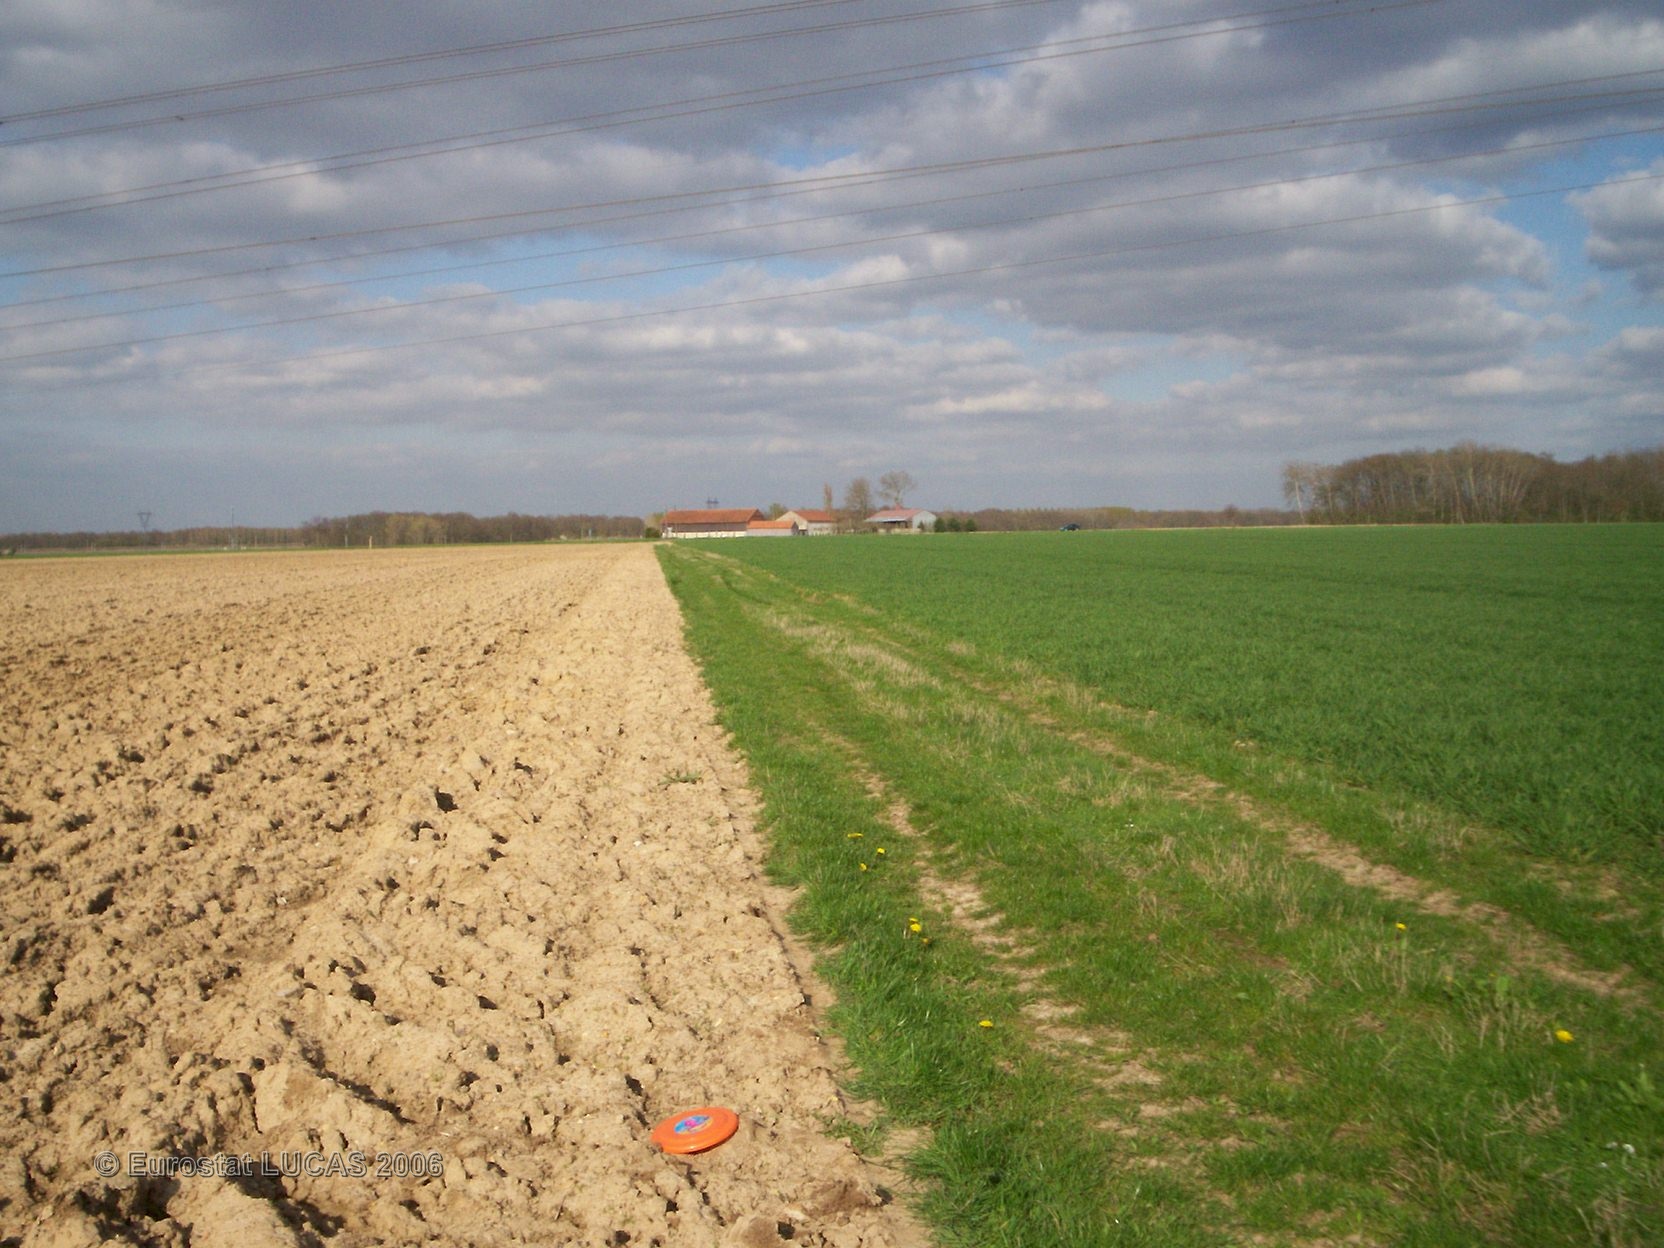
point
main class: Cropland
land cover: Maize
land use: Agriculture (excluding fallow land and kitchen gardens)
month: May
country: FR
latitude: 48.4780
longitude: 2.8349
